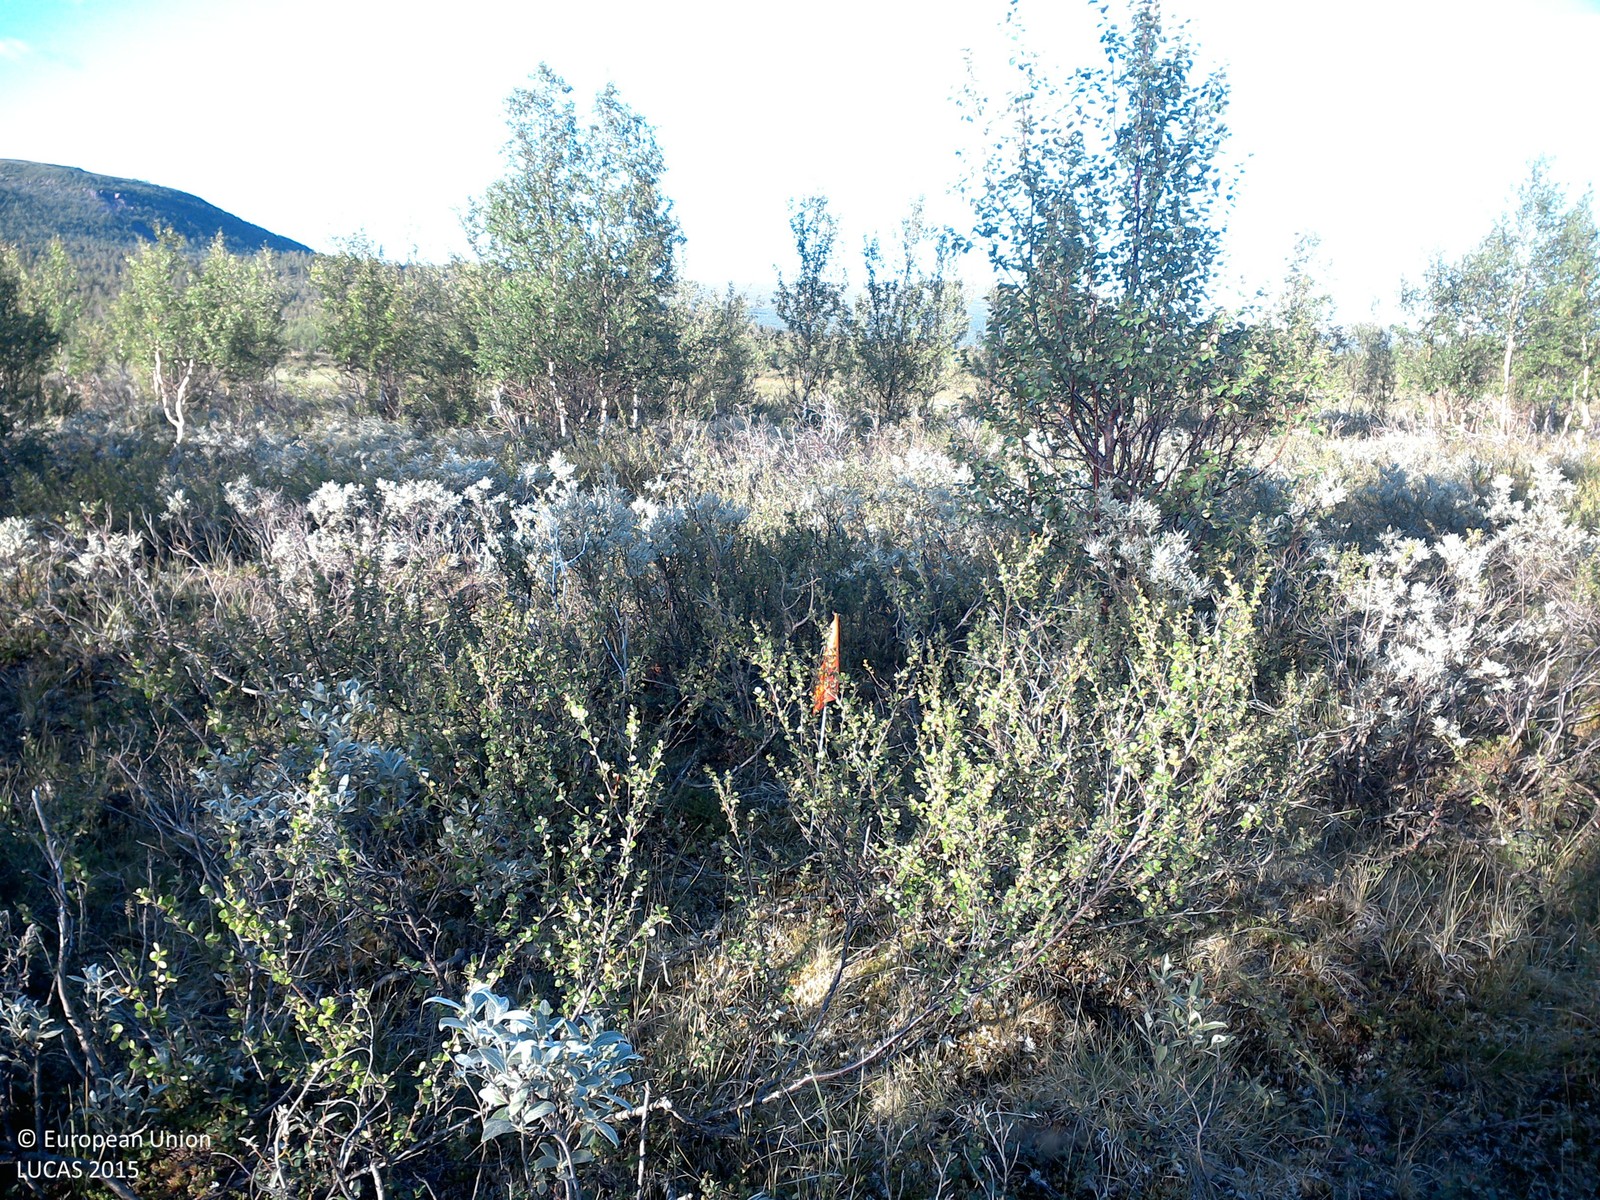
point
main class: Shrubland
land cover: Shrubland with sparse tree cover
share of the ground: > 75 %
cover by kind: shrubs 95 %, broadleaved forest trees 5 %
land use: Semi-natural and natural areas not in use
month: August
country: SE
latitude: 67.8599
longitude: 19.3770
